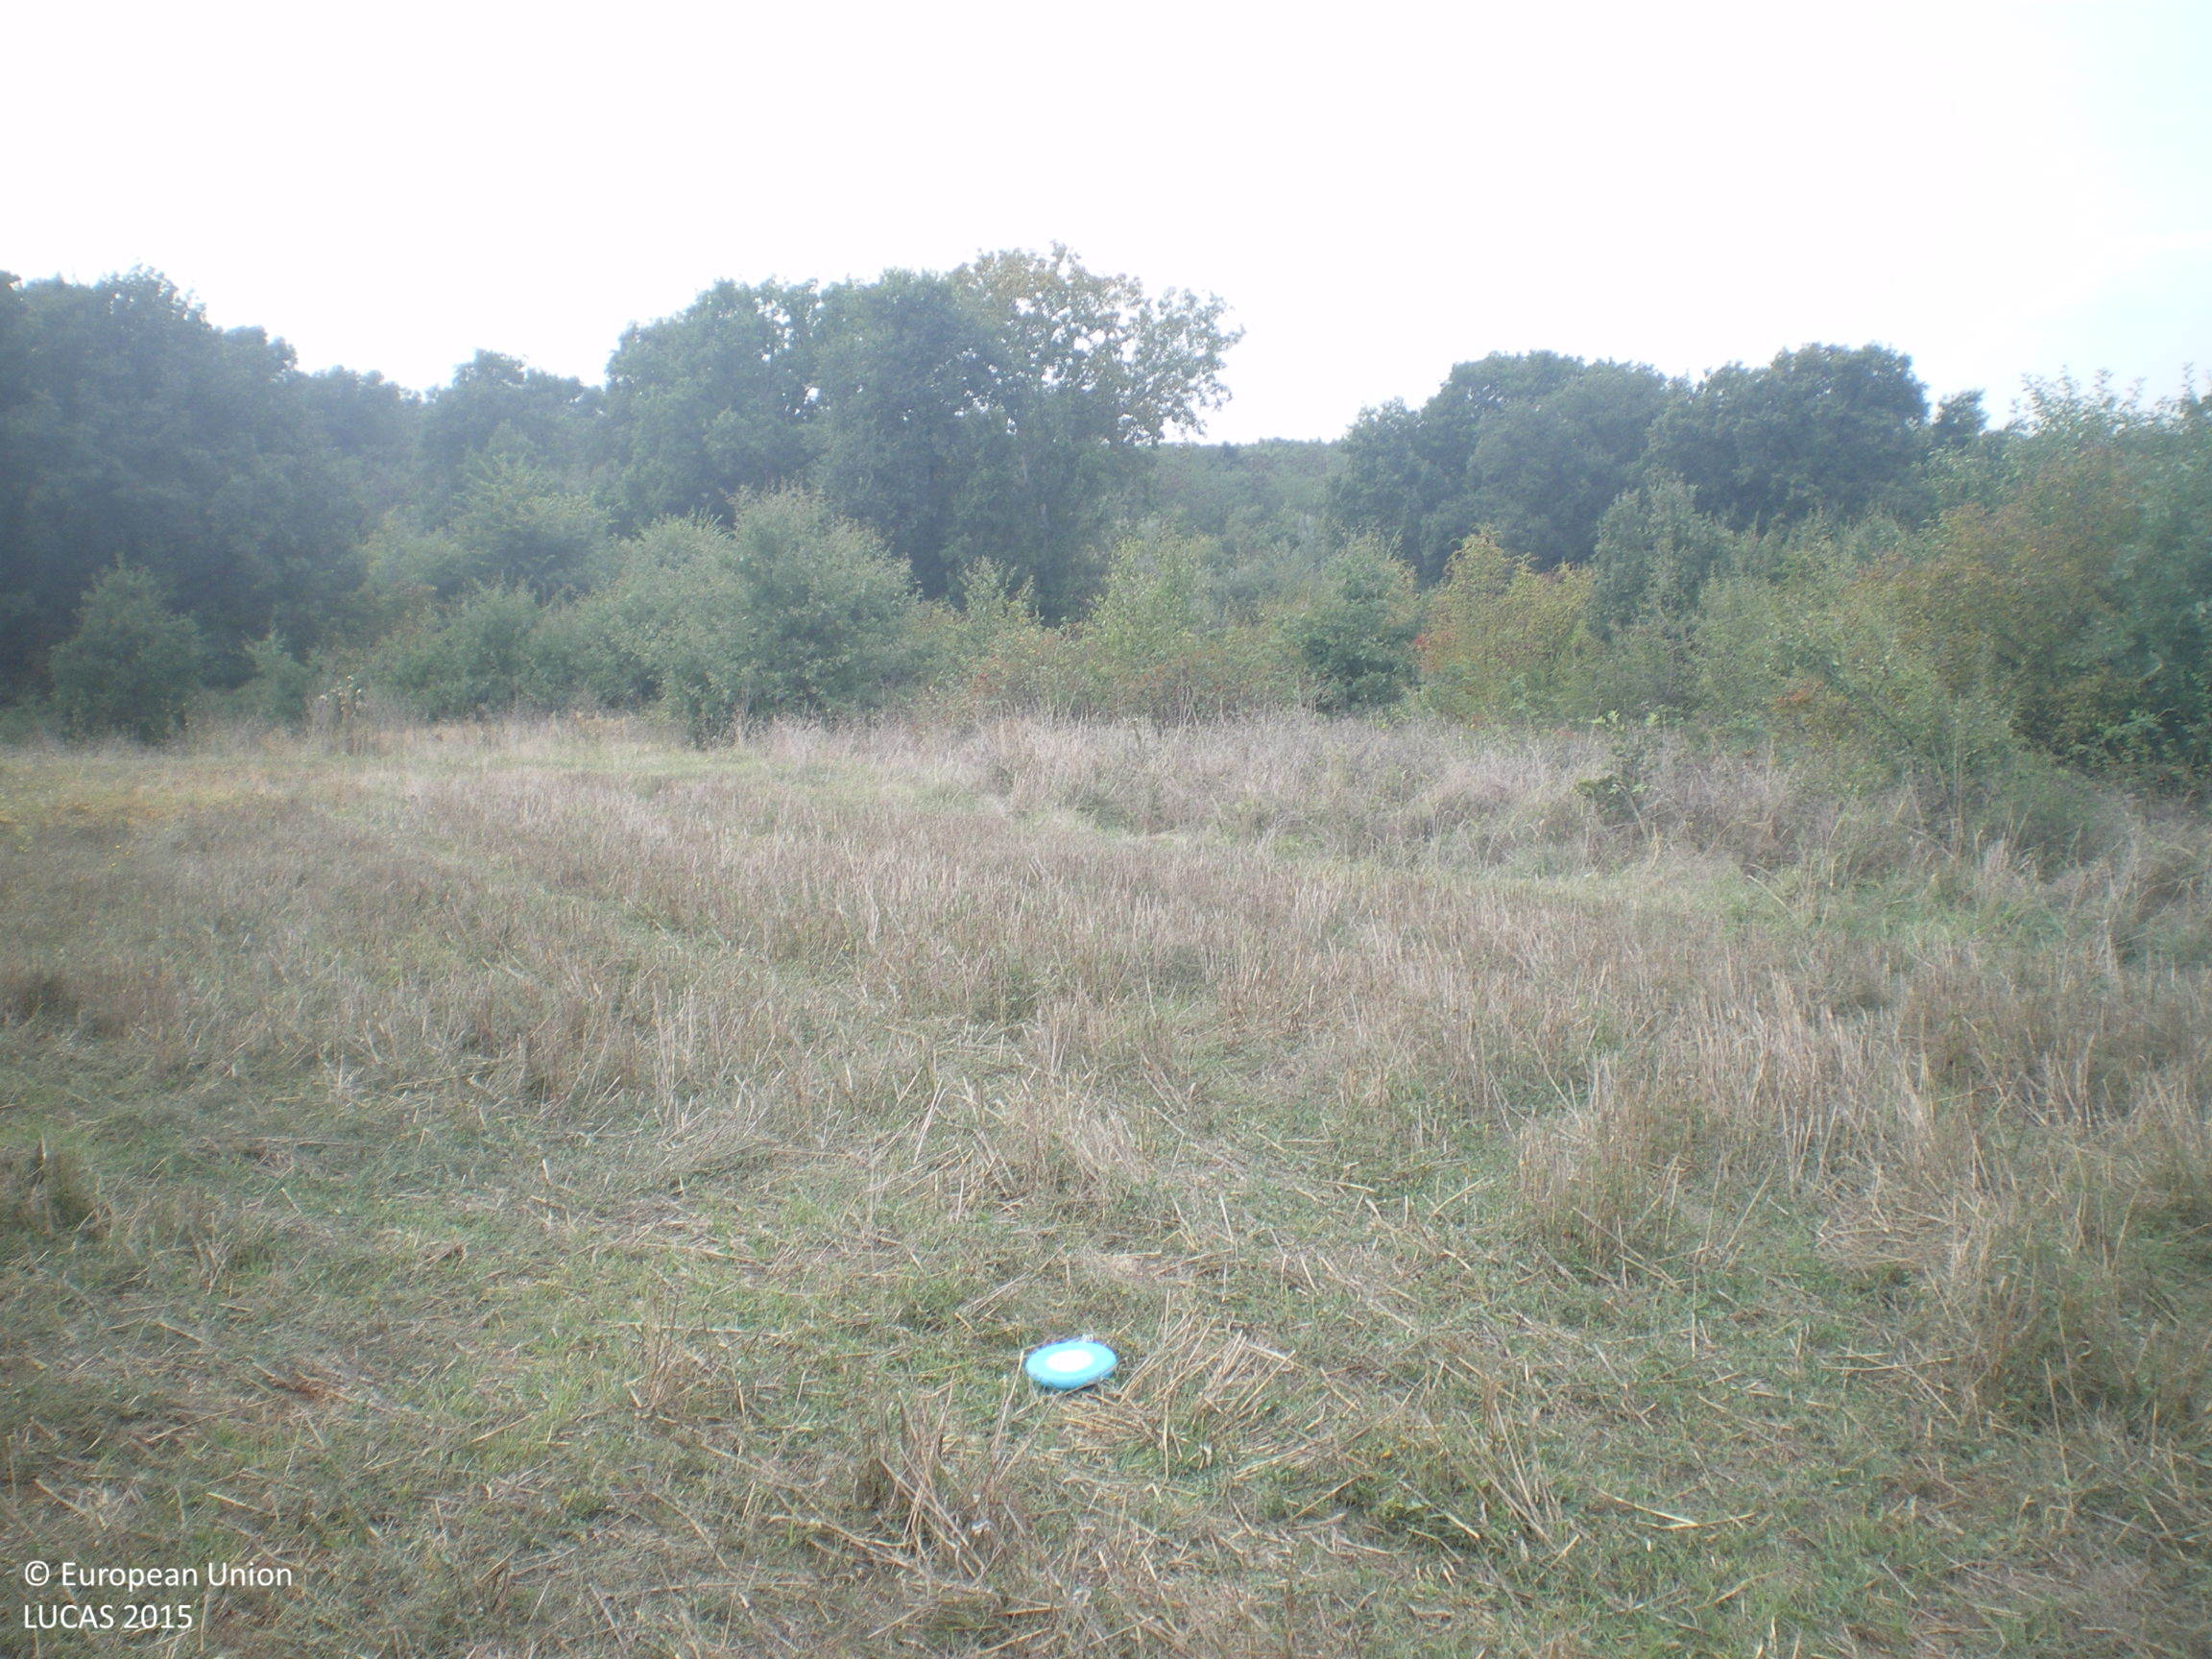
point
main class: Cropland
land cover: Common wheat
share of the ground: 10 - 25 %
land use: Agriculture (excluding fallow land and kitchen gardens)
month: September
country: BG
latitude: 42.0404
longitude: 25.9599
